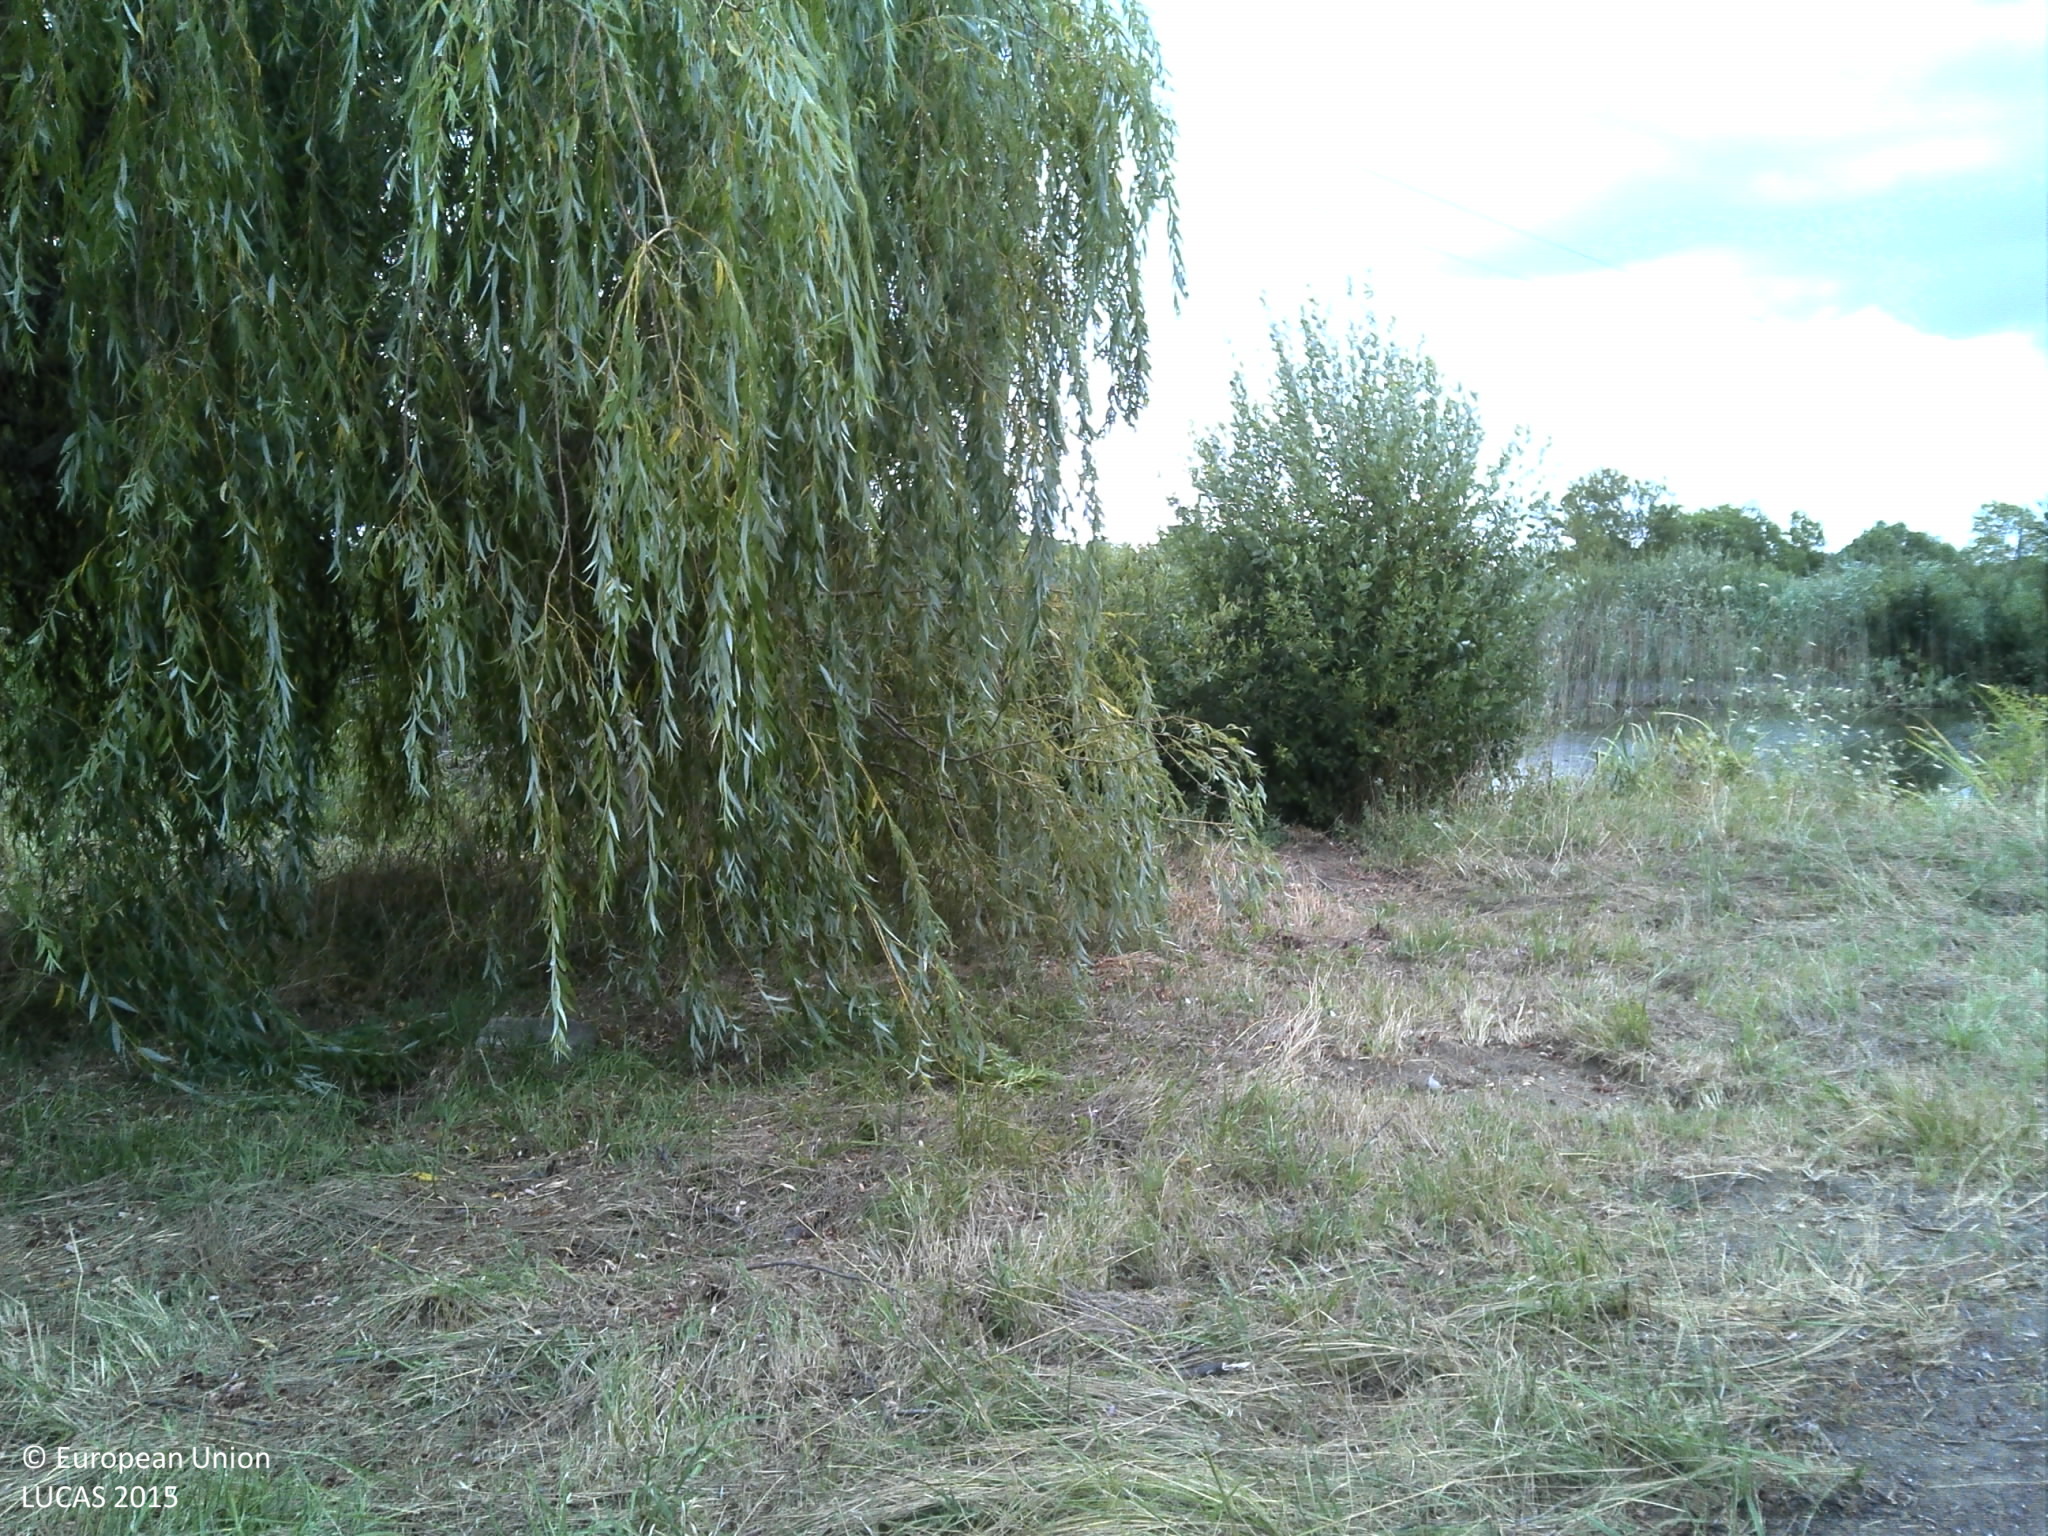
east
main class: Grassland
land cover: Grassland with sparse tree/shrub cover
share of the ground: > 75 %
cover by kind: herbaceous plants 95 %, broadleaved forest trees 5 %
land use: Residential
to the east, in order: Grassland with sparse tree/shrub cover; Inland fresh water bodies; Electric lines; Inland fresh water bodies; Abandoned hedges; Grassland without tree/shrub cover; Broadleaved woodland; Grassland without tree/shrub cover; Abandoned hedges; Grassland without tree/shrub cover; Fences; Broadleaved woodland
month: July
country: FR
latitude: 44.9660
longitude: -0.4524
